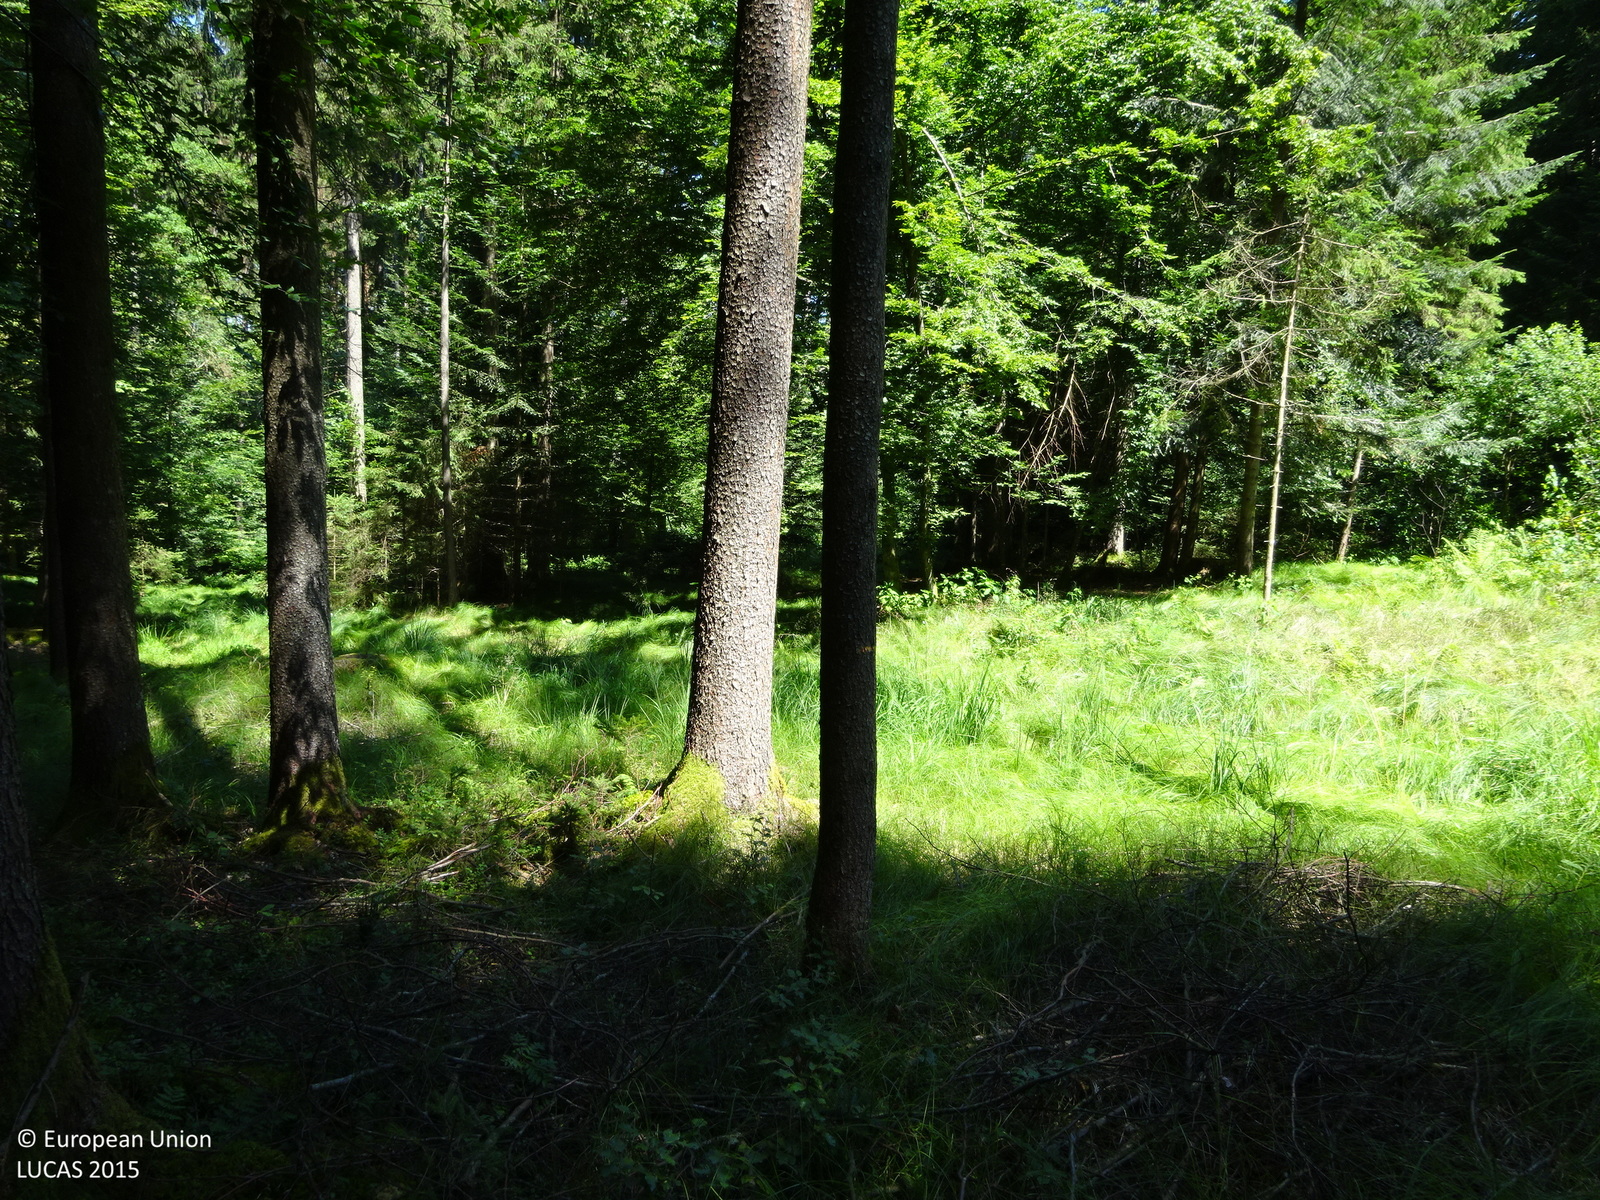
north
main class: Woodland
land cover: Spruce dominated mixed woodland
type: mountainous beech forest
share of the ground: > 75 %
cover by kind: broadleaved forest trees 60 %, coniferous forest trees 30 %, herbaceous plants 5 %, lichens and mosses 5 %
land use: Forestry
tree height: > 5 m
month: July
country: AT
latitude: 46.8869
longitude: 15.3142
